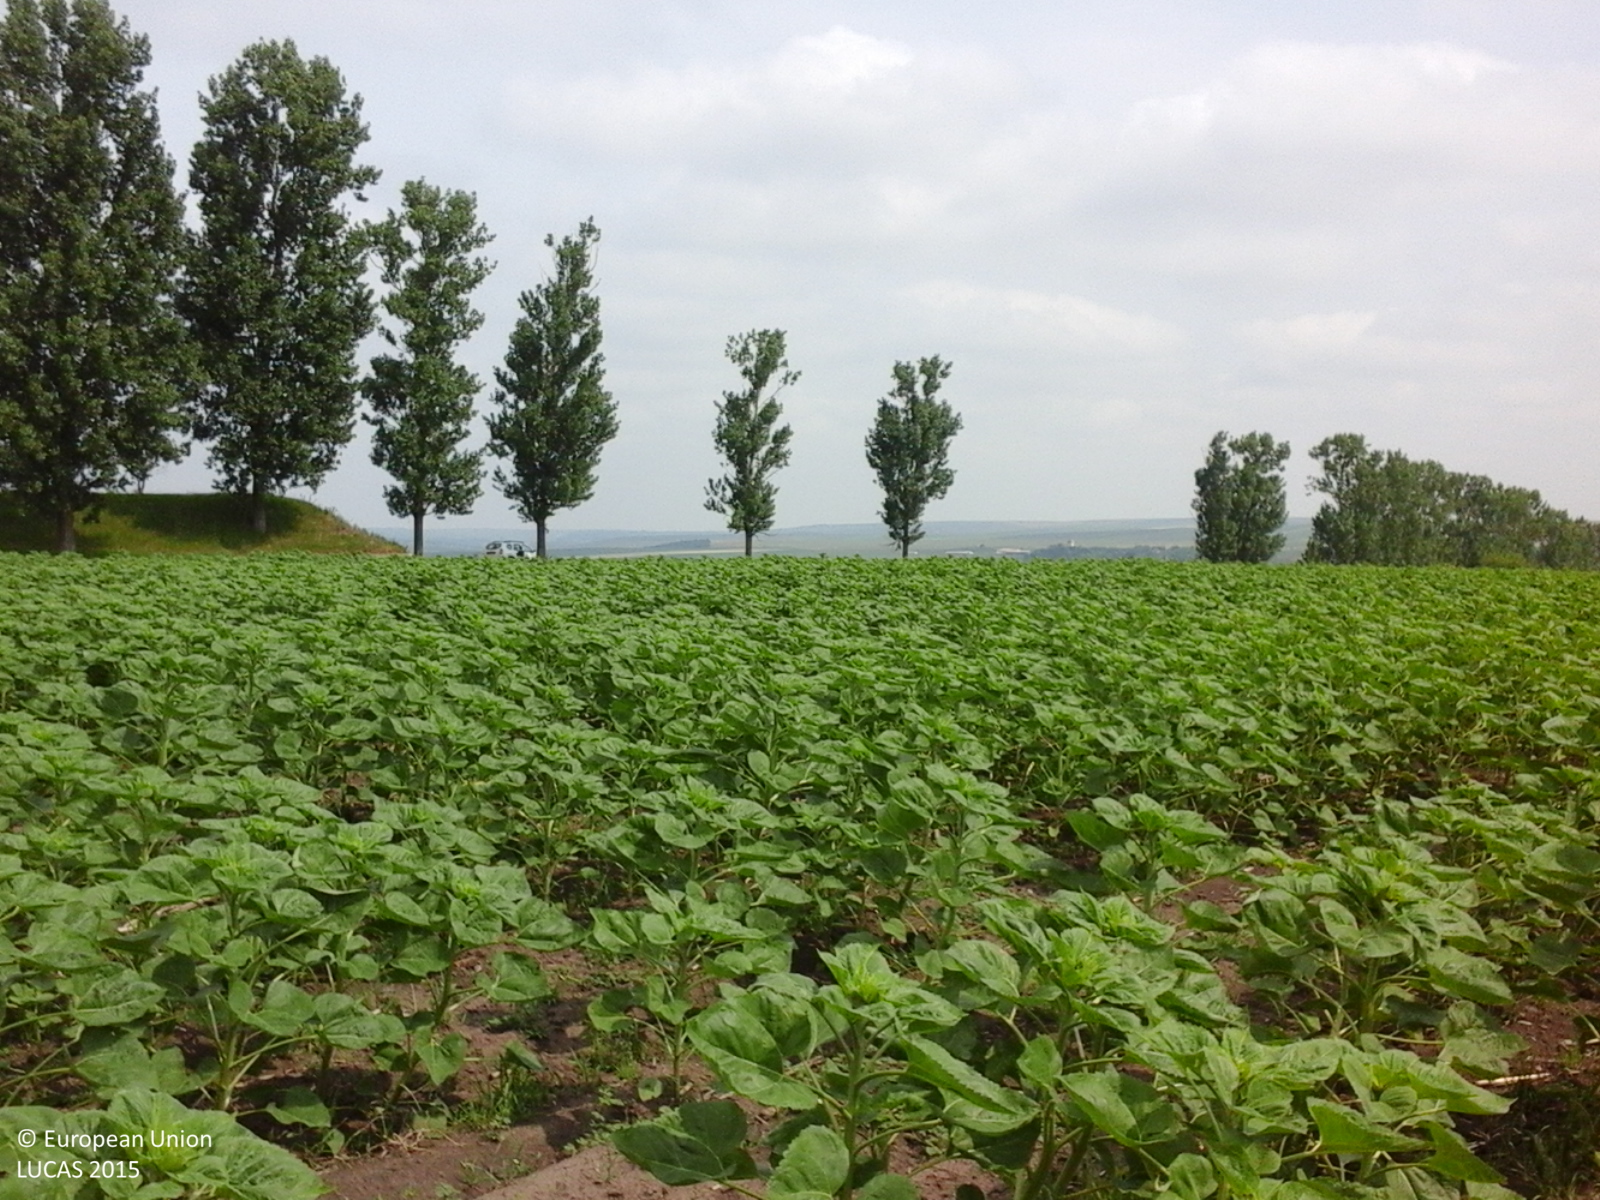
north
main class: Cropland
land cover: Sunflower
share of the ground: > 75 %
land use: Agriculture (excluding fallow land and kitchen gardens)
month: June
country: RO
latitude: 47.7888
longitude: 26.6606
